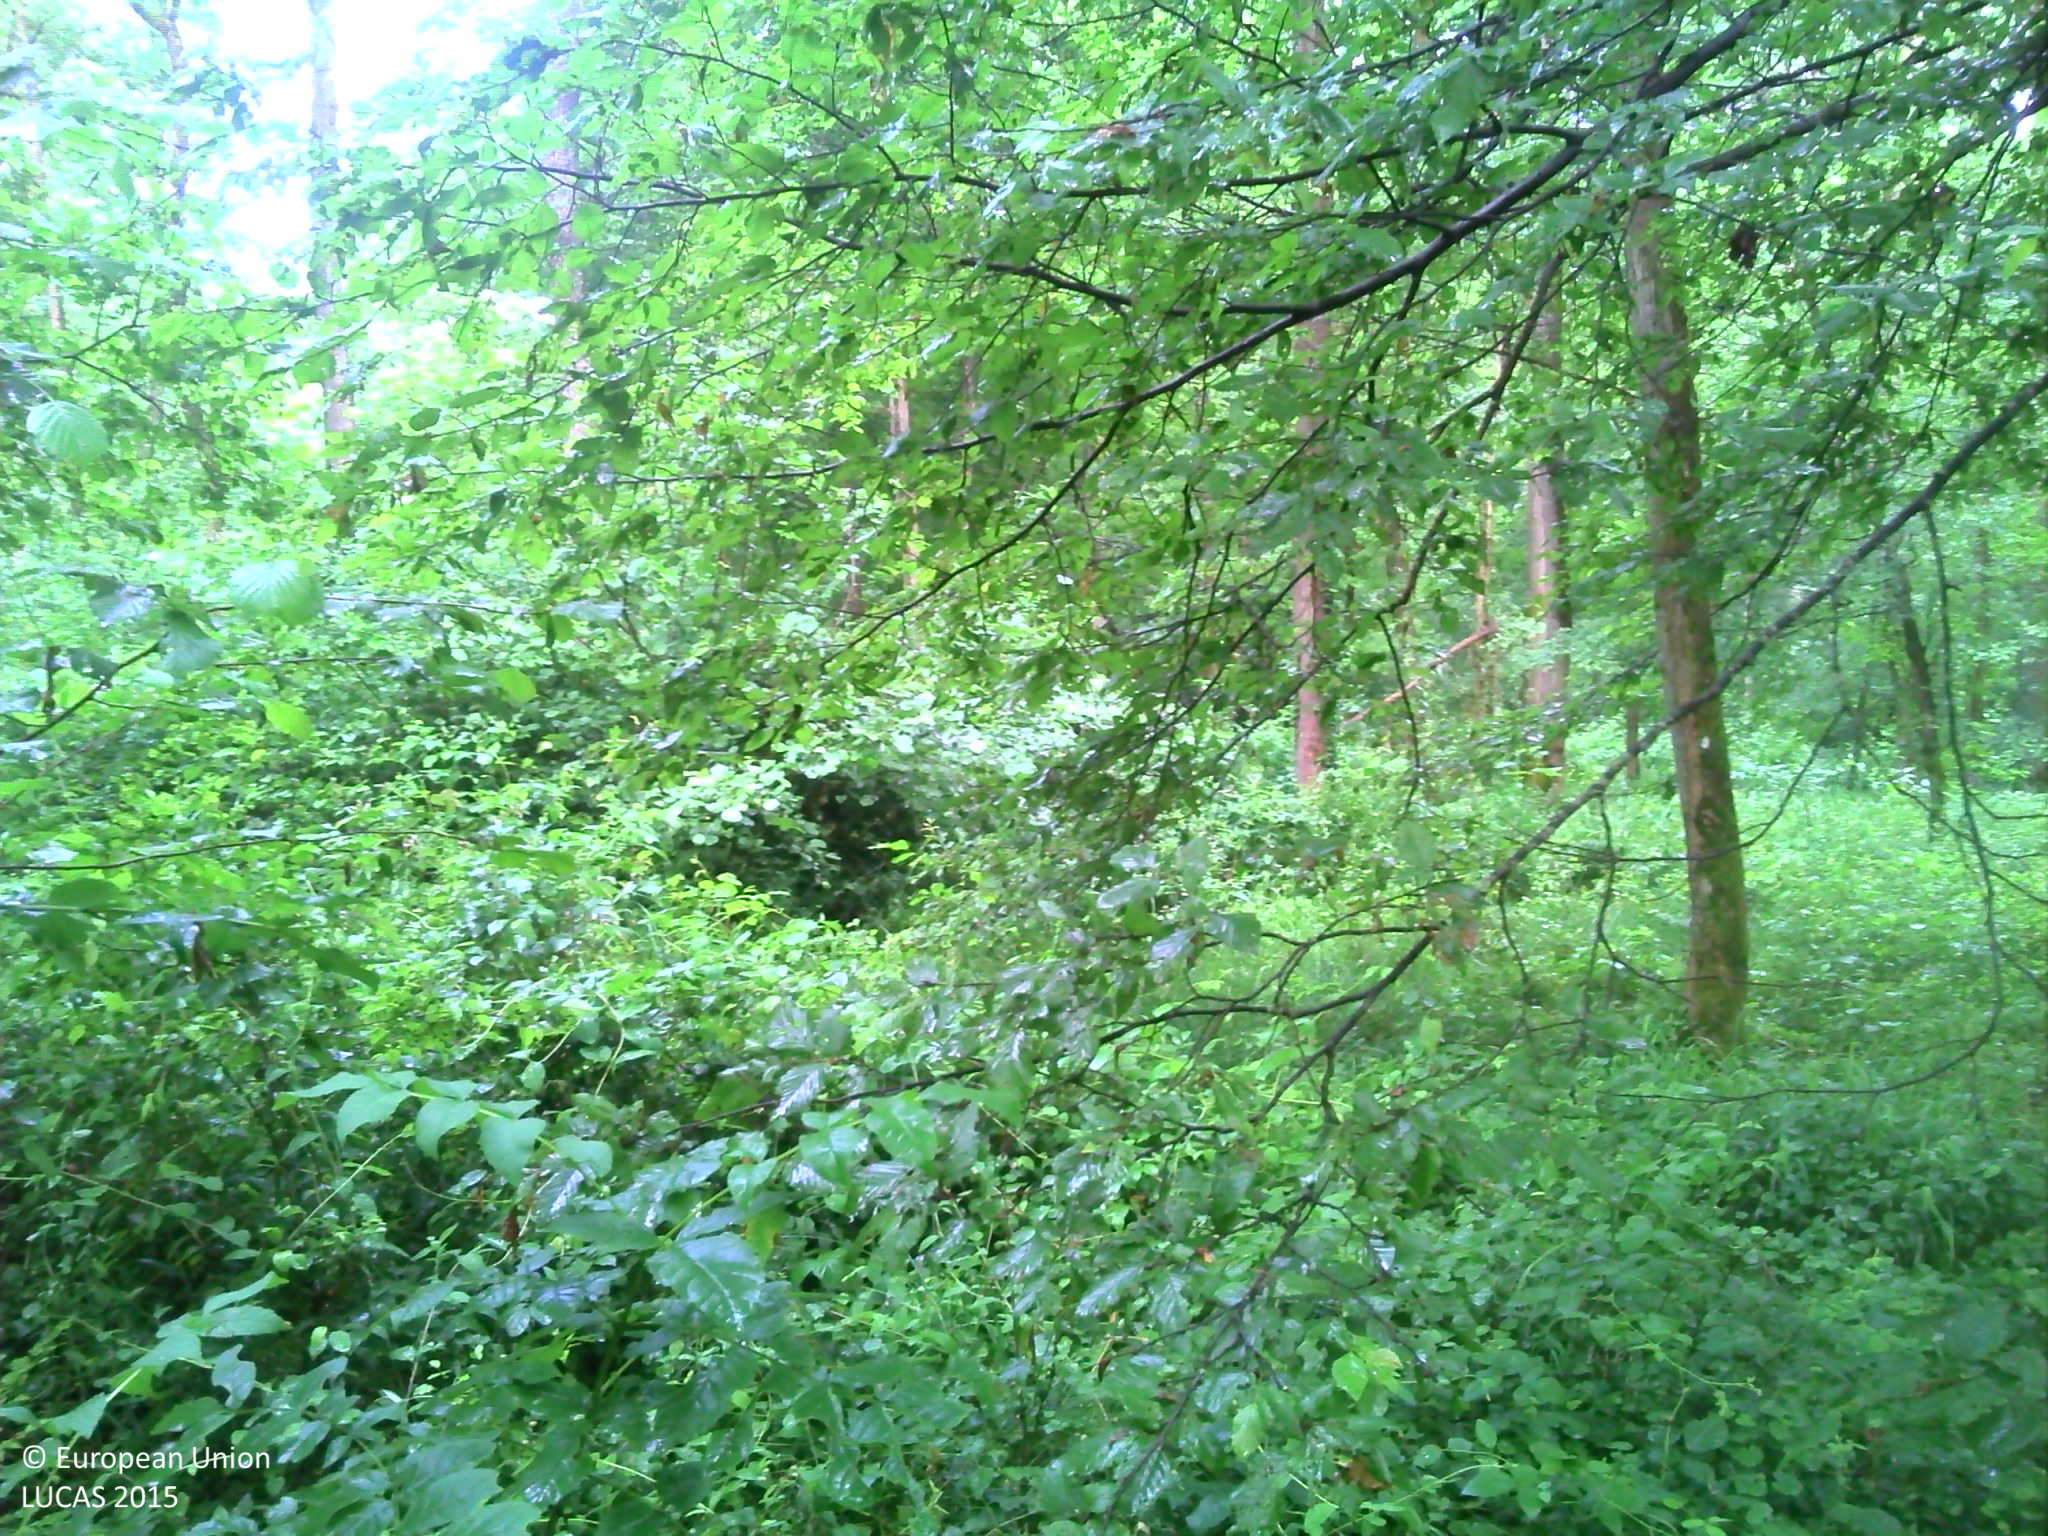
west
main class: Woodland
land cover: Broadleaved woodland
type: mesophytic deciduous forest
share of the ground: > 75 %
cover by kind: broadleaved forest trees 95 %, herbaceous plants 5 %
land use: Forestry
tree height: > 5 m
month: June
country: FR
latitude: 48.3579
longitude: 7.5312
